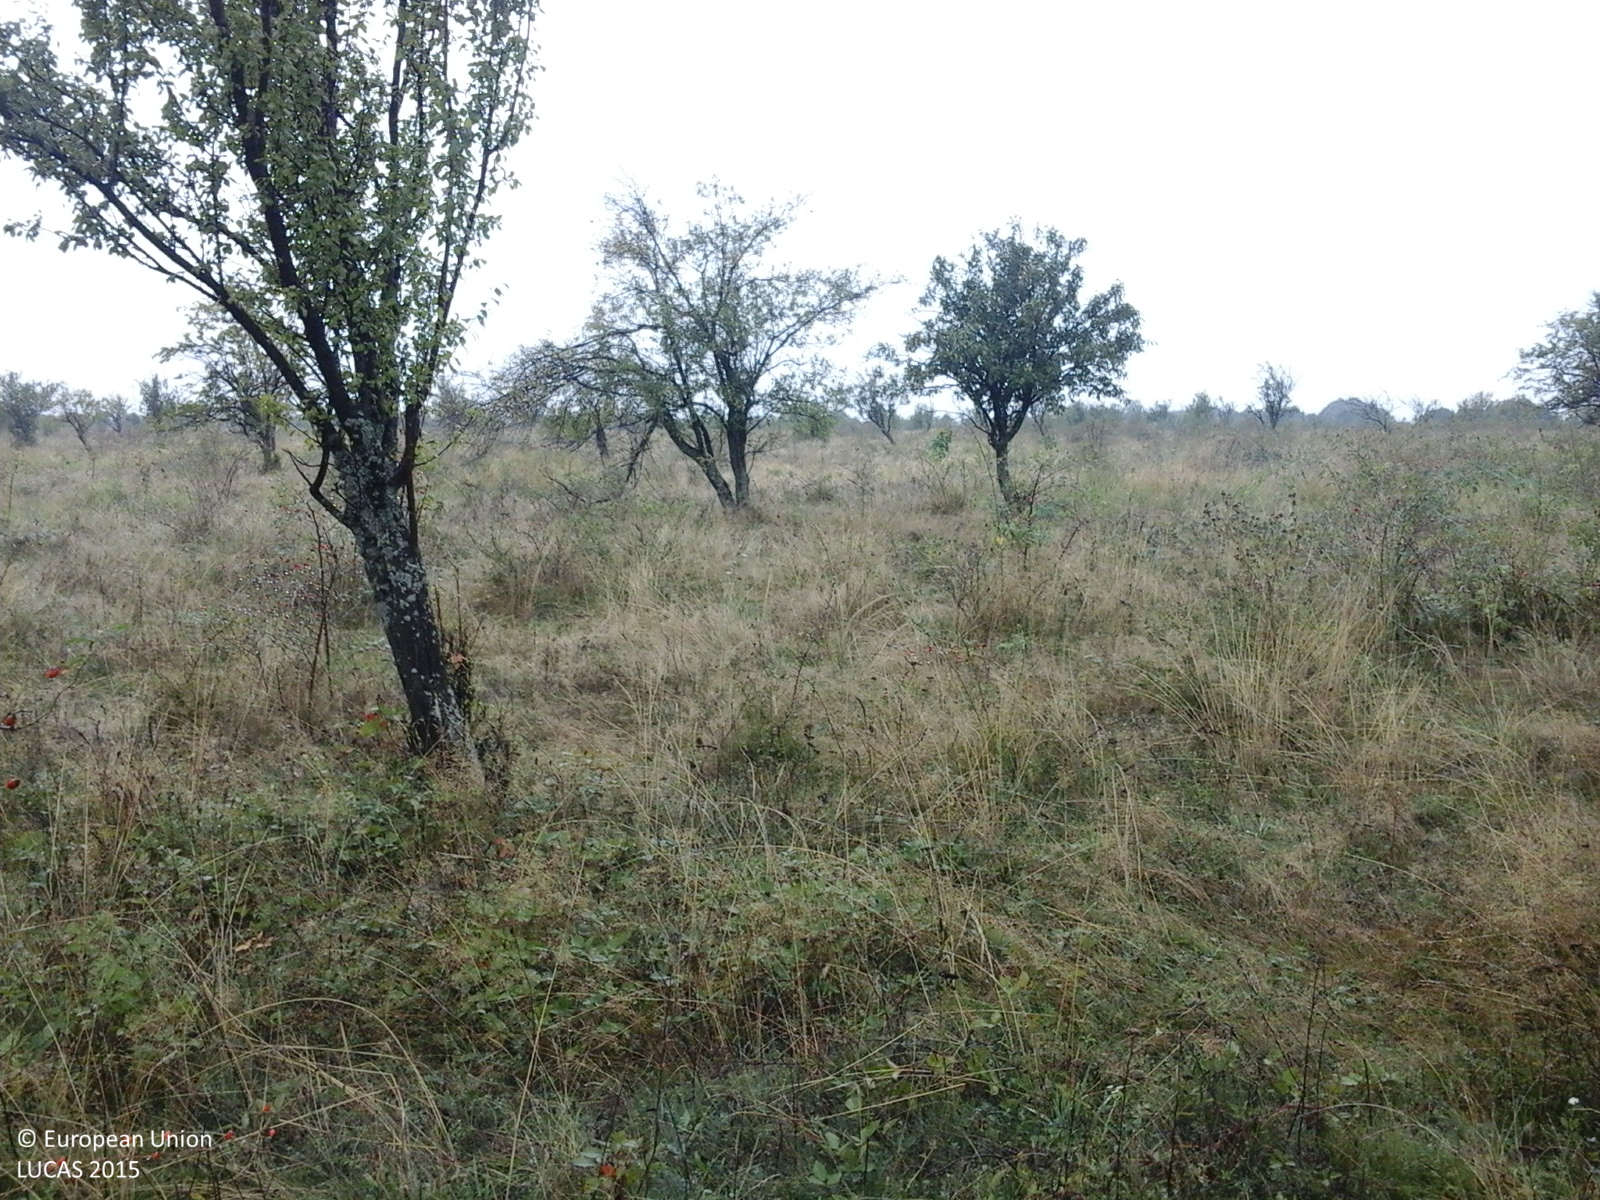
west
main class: Cropland
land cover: Apple fruit
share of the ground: 50 - 75 %
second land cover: Grassland without tree/shrub cover
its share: > 75 %
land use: Agriculture (excluding fallow land and kitchen gardens)
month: September
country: RO
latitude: 45.0809
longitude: 23.5631
